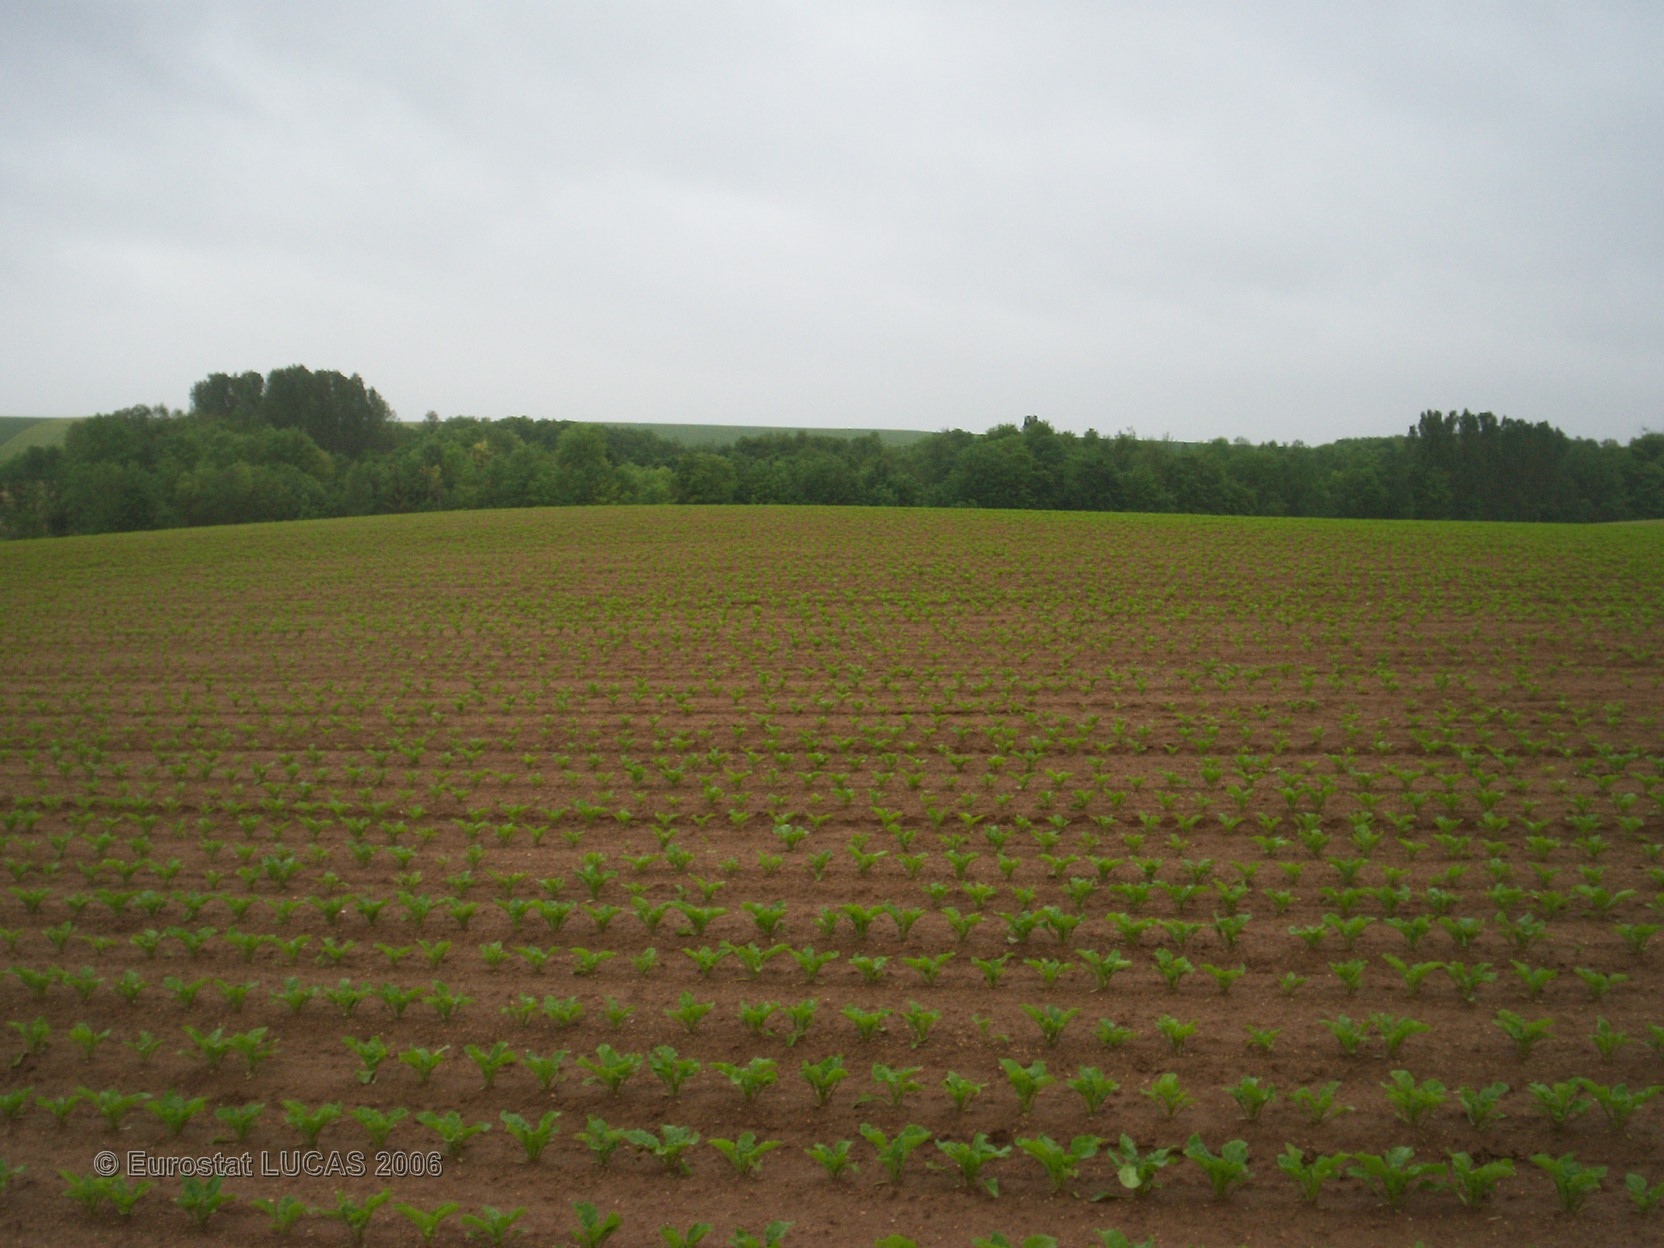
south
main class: Cropland
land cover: Sugar beet
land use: Agriculture (excluding fallow land and kitchen gardens)
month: May
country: FR
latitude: 49.4150
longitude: 4.3859
